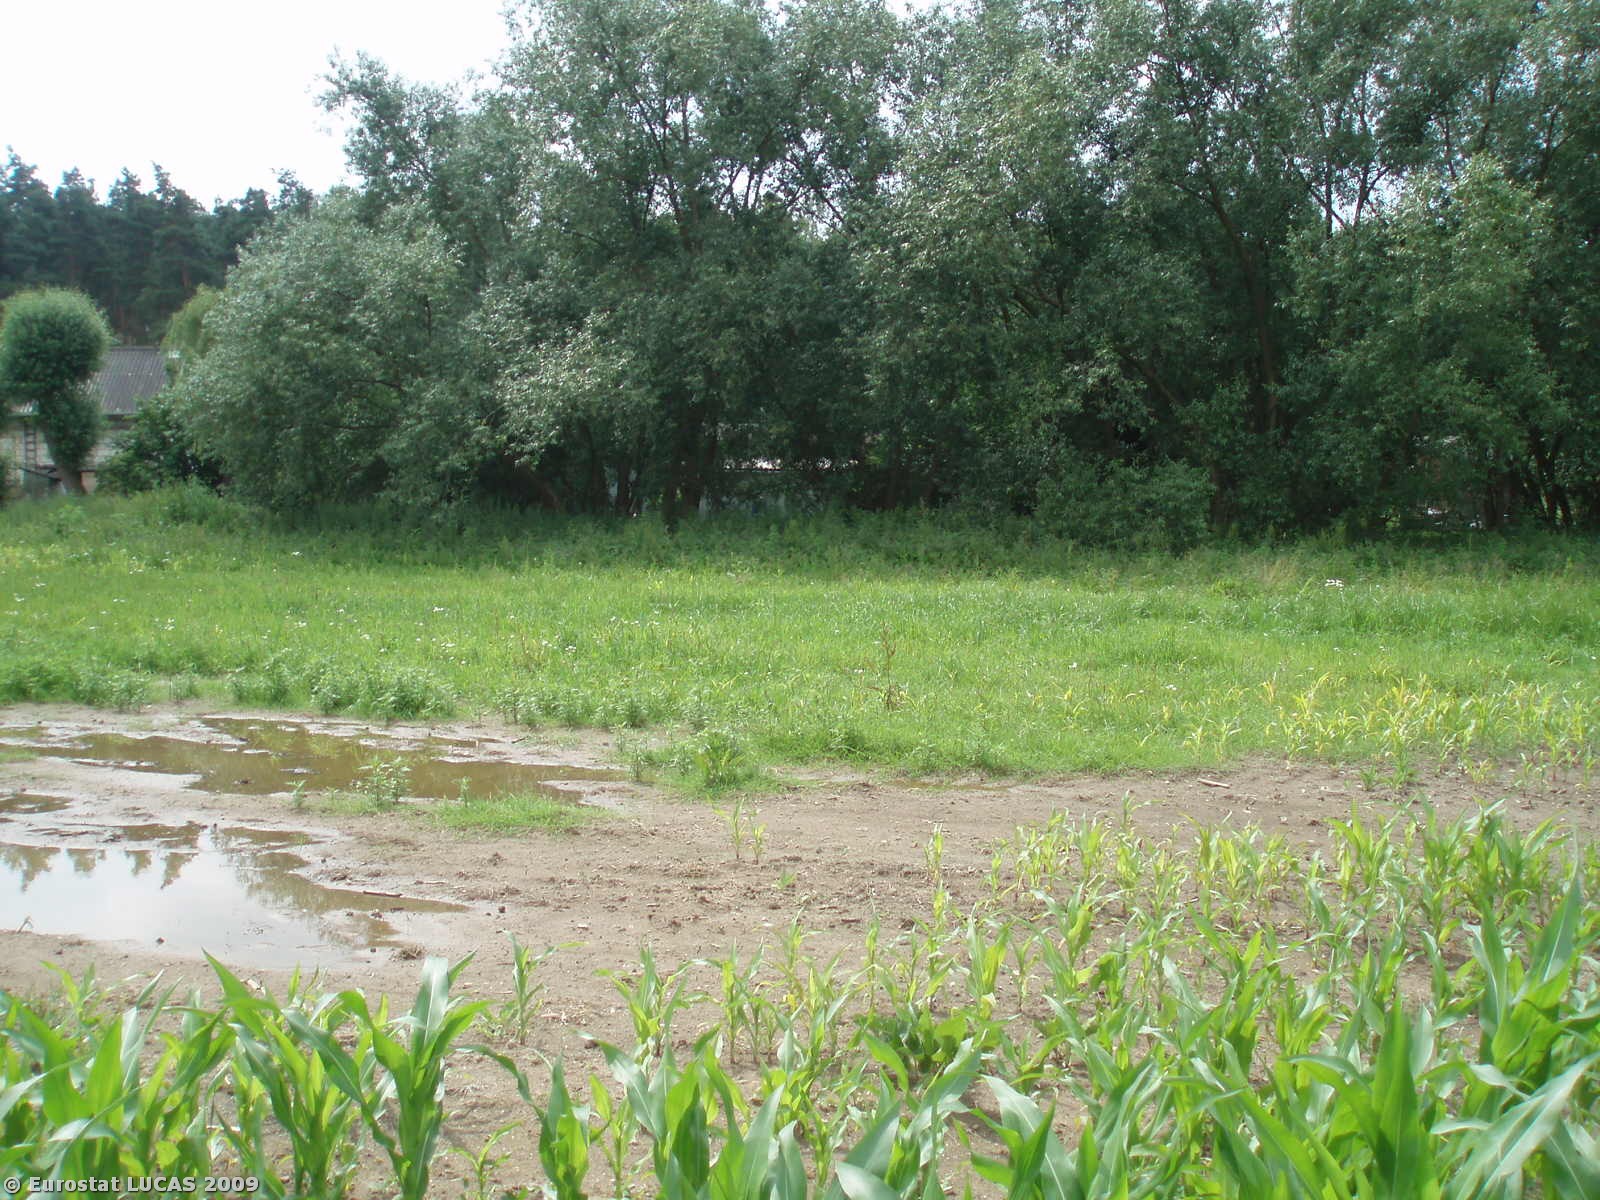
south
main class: Cropland
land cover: Maize
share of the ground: > 75 %
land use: Agriculture (excluding fallow land and kitchen gardens)
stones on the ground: < 10 %
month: June
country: CZ
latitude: 49.7073
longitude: 13.2032
